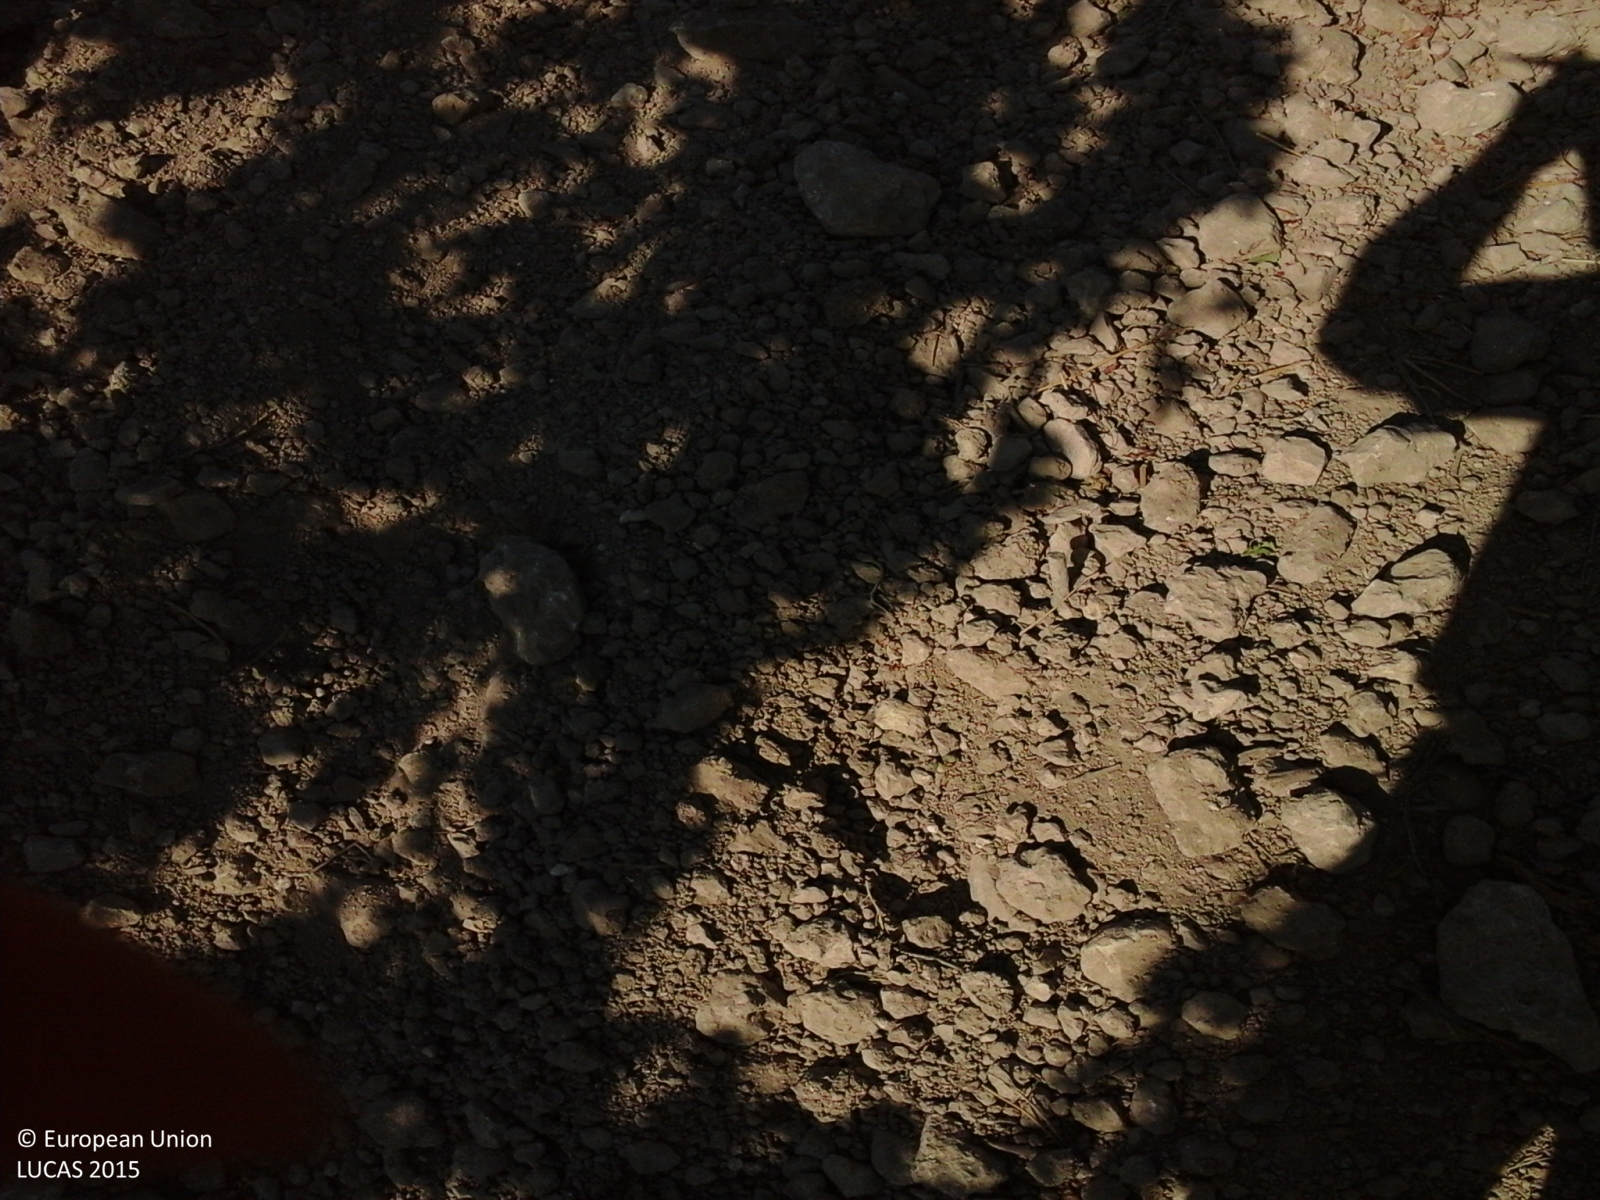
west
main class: Cropland
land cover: Vineyards
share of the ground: > 75 %
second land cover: Other bare soil
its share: > 75 %
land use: Agriculture (excluding fallow land and kitchen gardens)
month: July
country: IT
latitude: 37.2408
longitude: 14.1052
